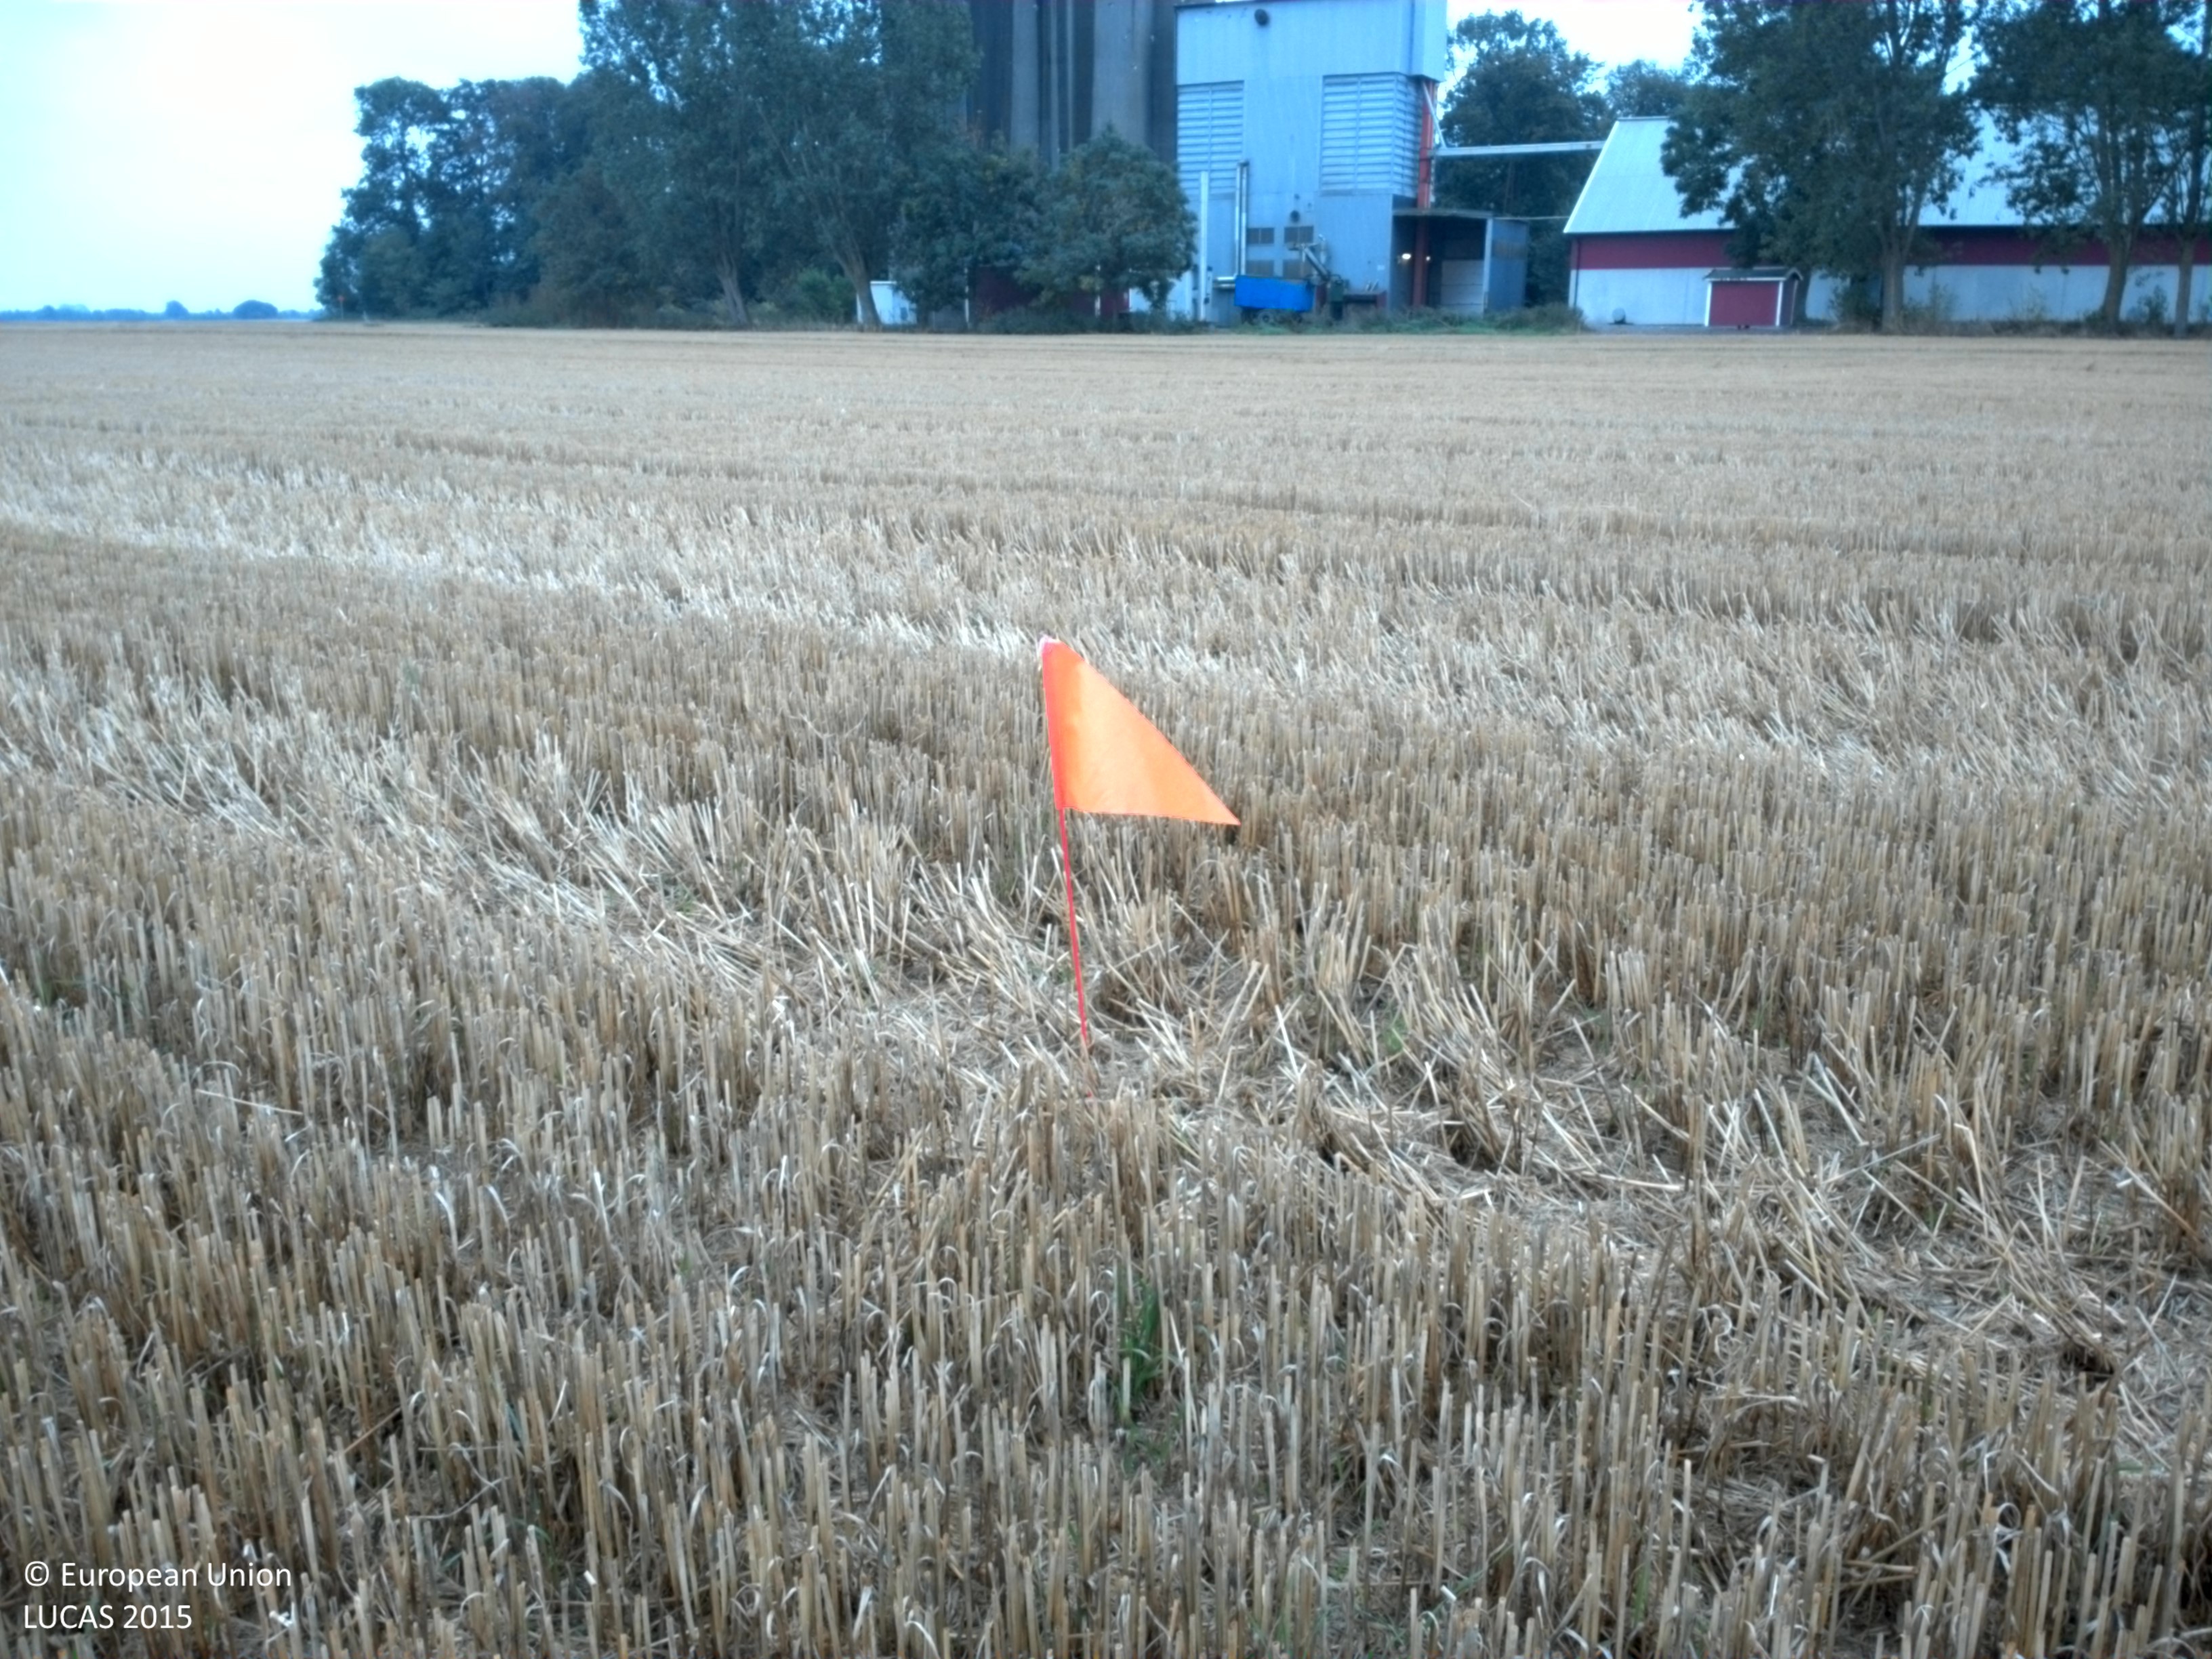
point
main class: Cropland
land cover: Common wheat
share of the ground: 50 - 75 %
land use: Agriculture (excluding fallow land and kitchen gardens)
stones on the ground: < 10 %
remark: Harvested field
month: September
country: SE
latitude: 55.9048
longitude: 12.8289
